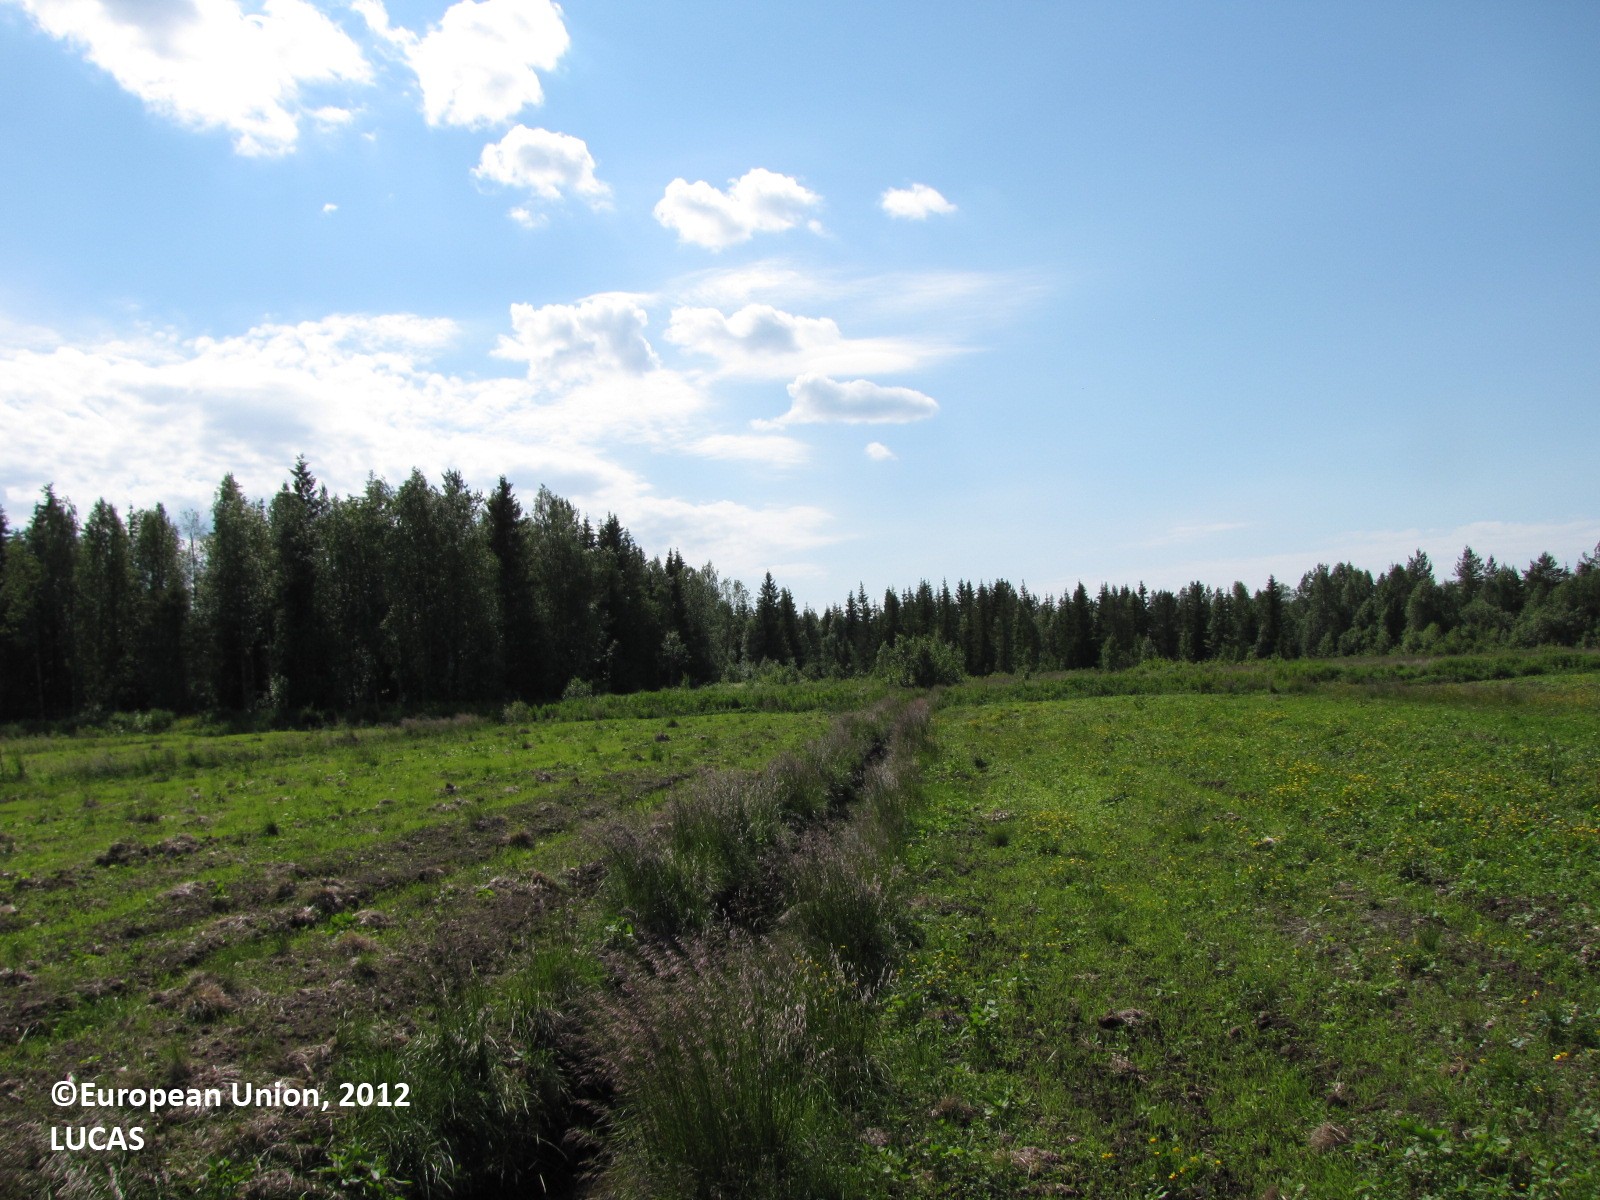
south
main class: Grassland
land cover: Grassland without tree/shrub cover
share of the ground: > 75 %
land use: Agriculture (excluding fallow land and kitchen gardens)
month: July
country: FI
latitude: 66.2650
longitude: 25.2235
